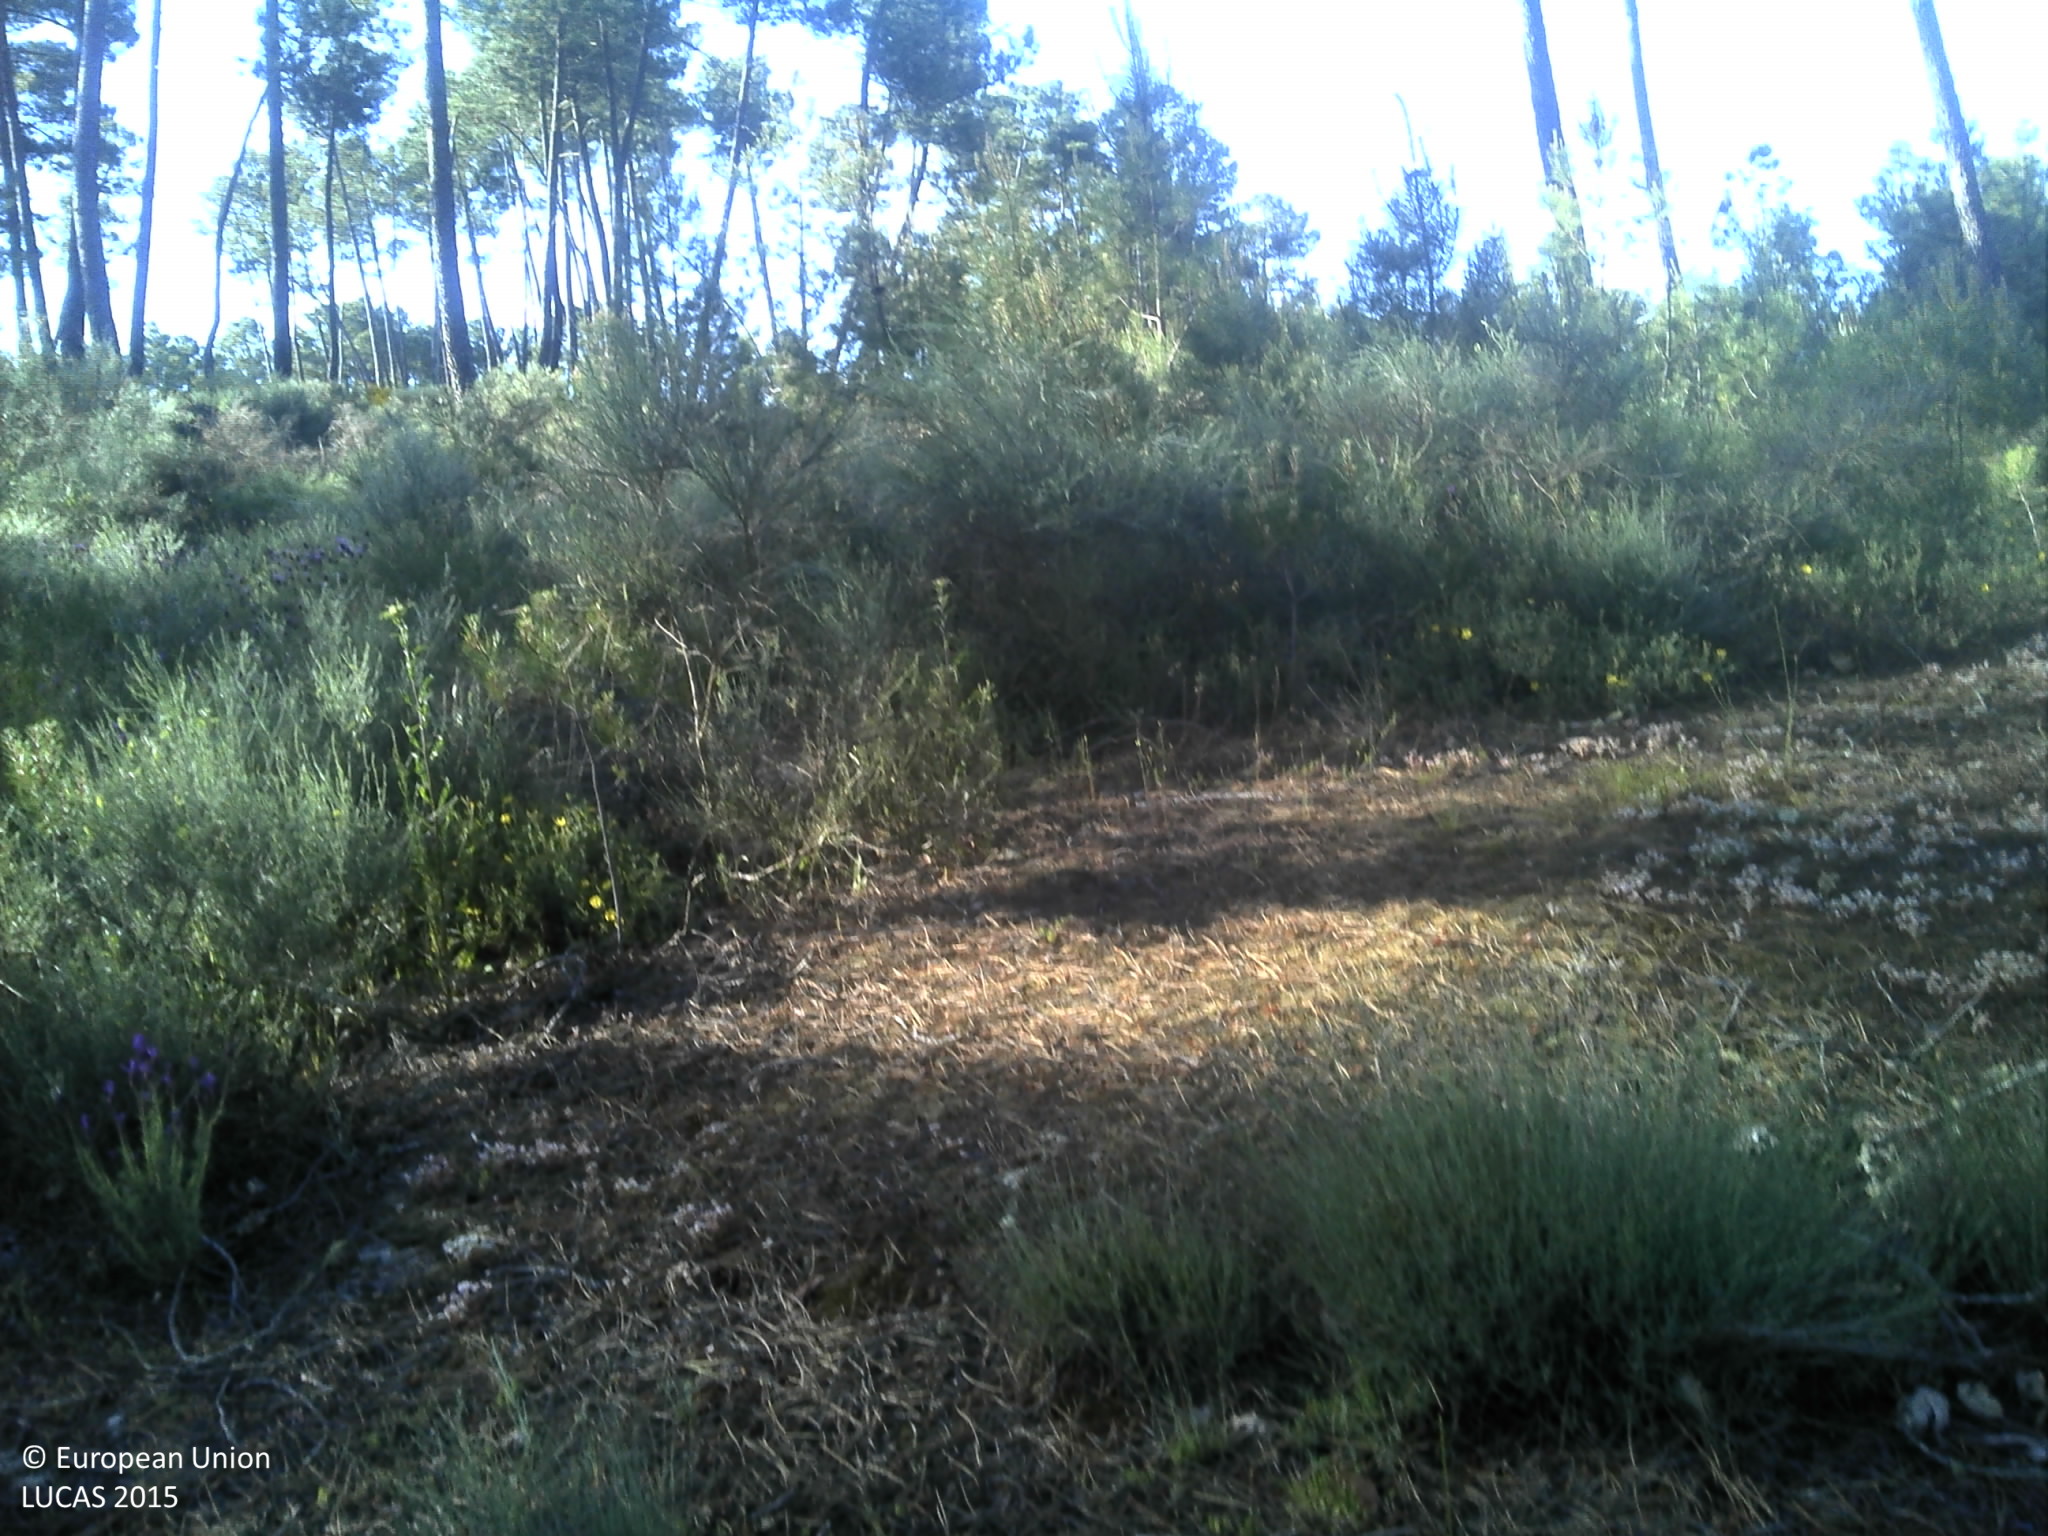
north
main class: Woodland
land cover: Pine dominated coniferous woodland
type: coniferous forest of the mediterranean region
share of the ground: 25 - 50 %
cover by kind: coniferous forest trees 60 %, shrubs 10 %, herbaceous plants 10 %, unconsolidated bare surface 10 %
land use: Forestry
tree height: > 5 m
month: May
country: PT
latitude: 40.7245
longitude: -7.2155
